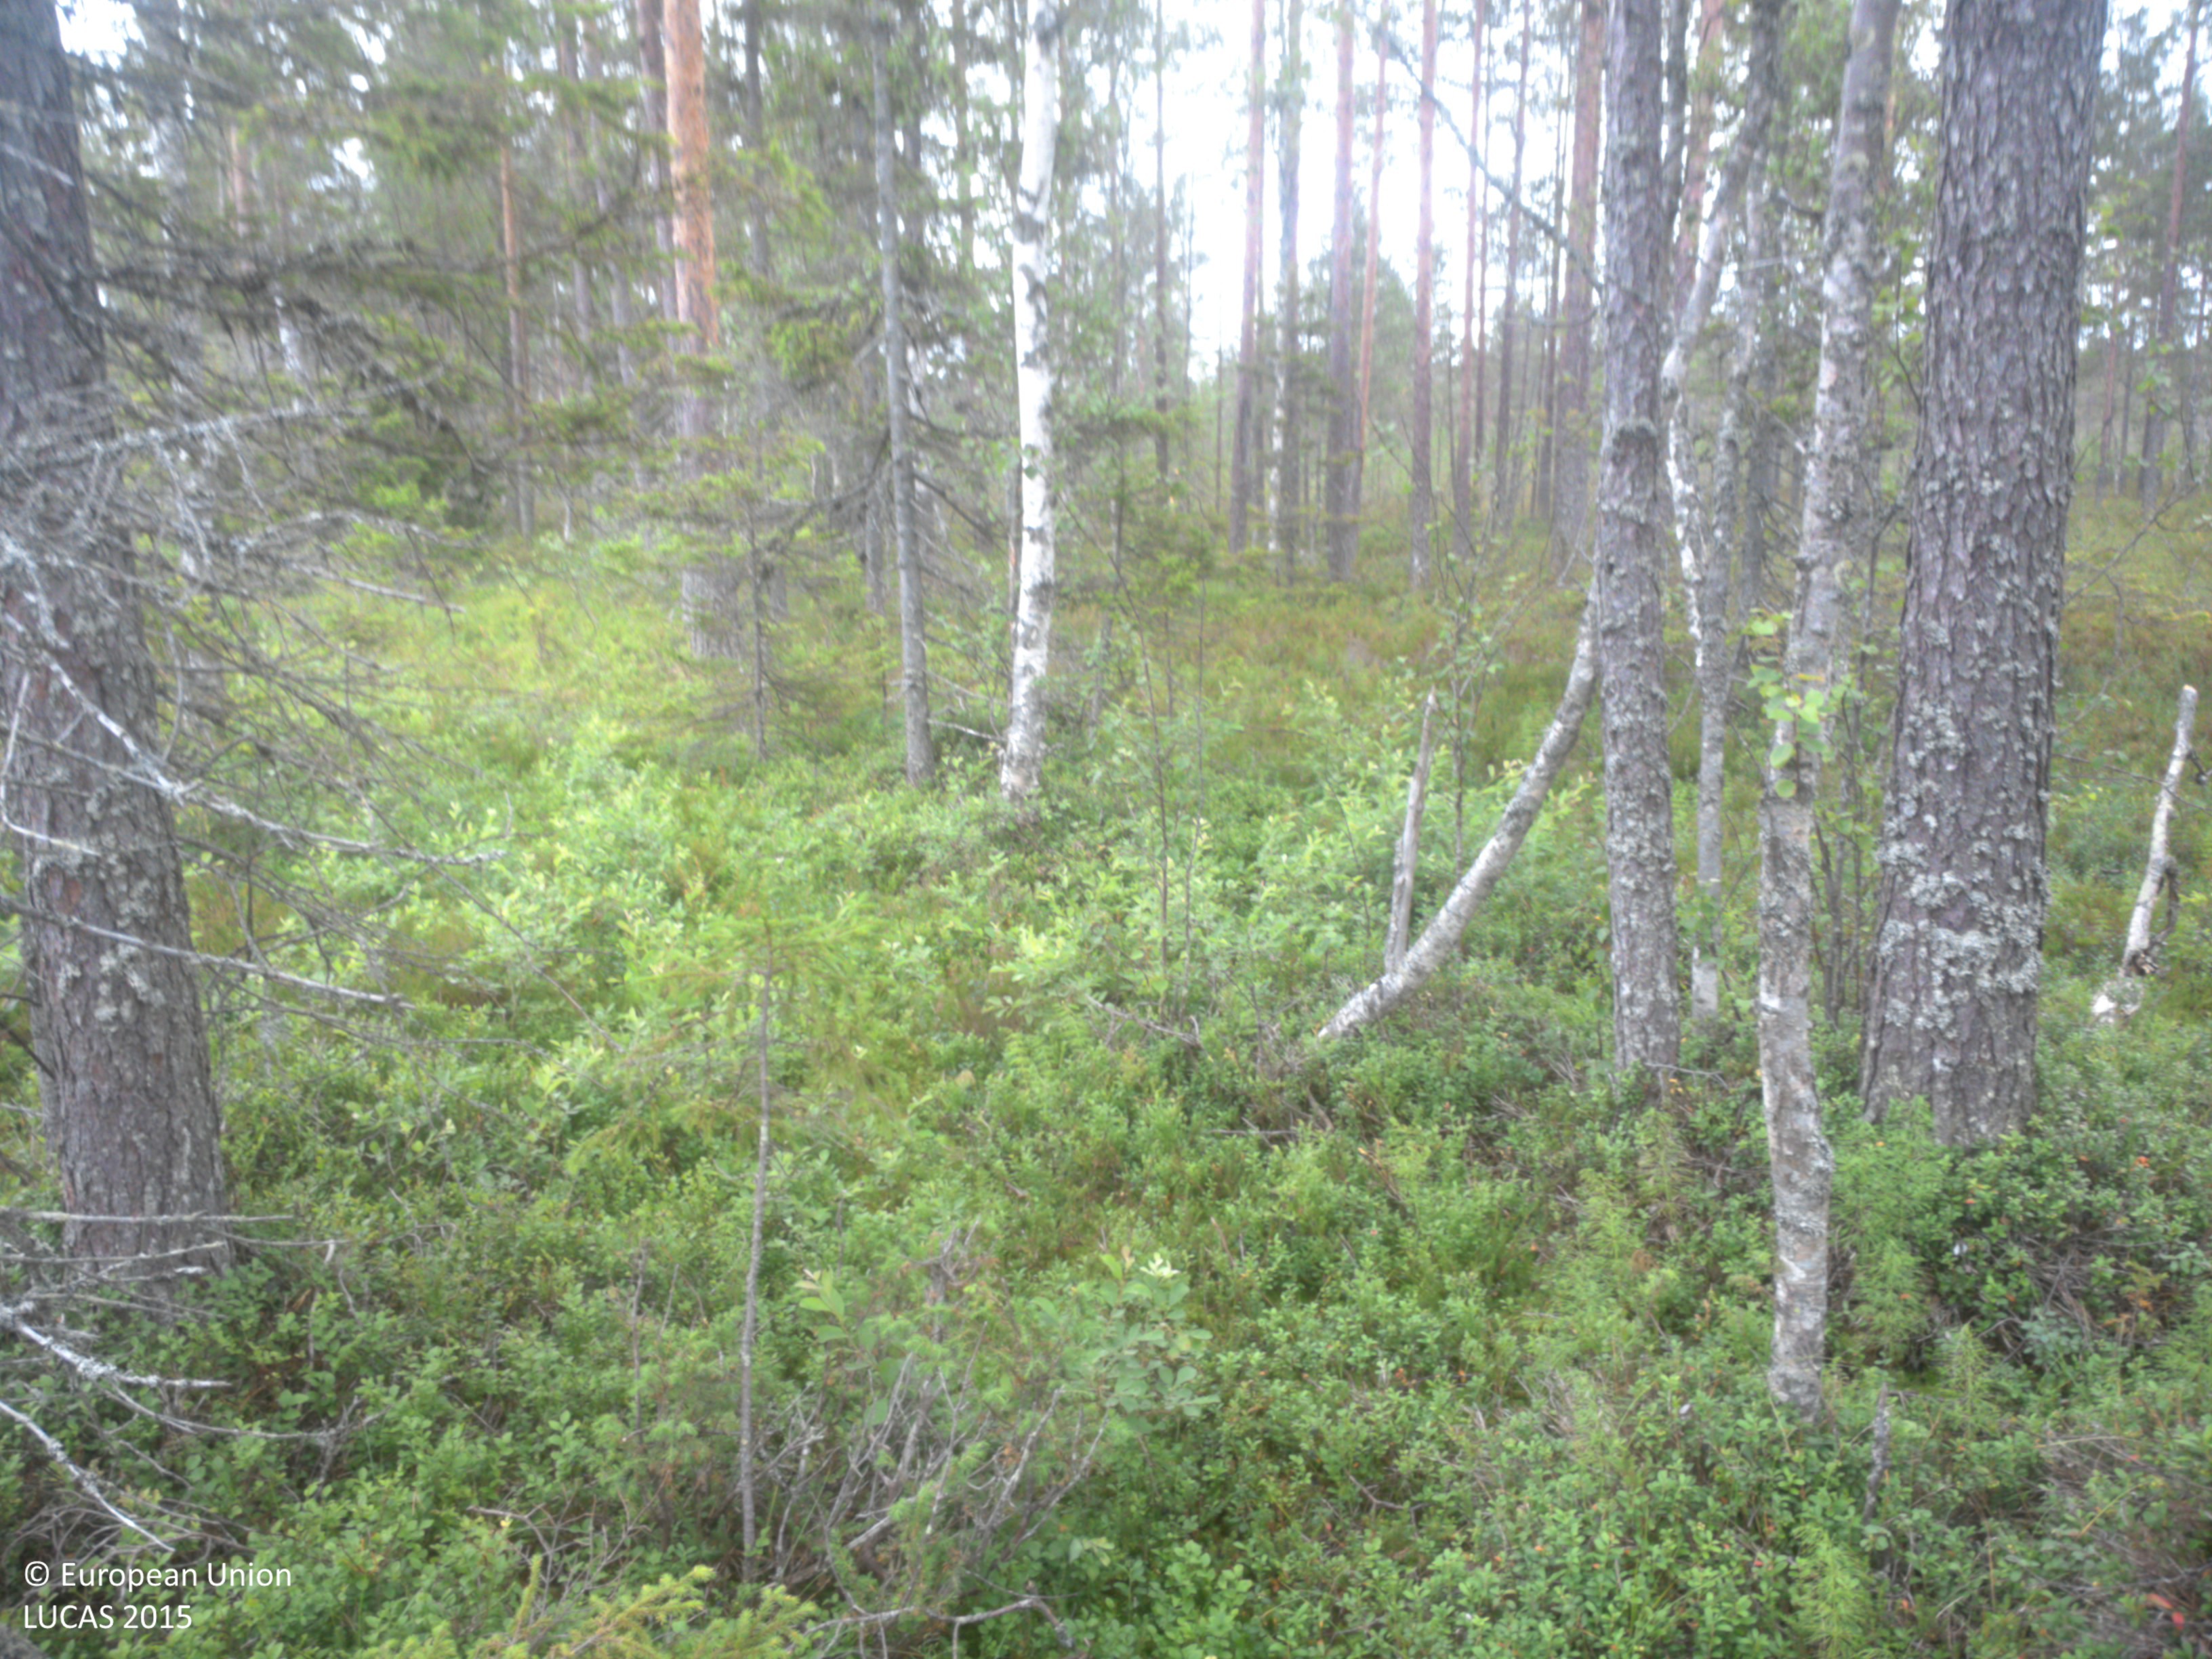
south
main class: Woodland
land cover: Pine dominated coniferous woodland
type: boreal forest
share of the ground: 25 - 50 %
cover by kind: shrubs 55 %, coniferous forest trees 45 %
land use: Forestry
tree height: > 5 m
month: August
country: SE
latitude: 63.7072
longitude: 19.8751
